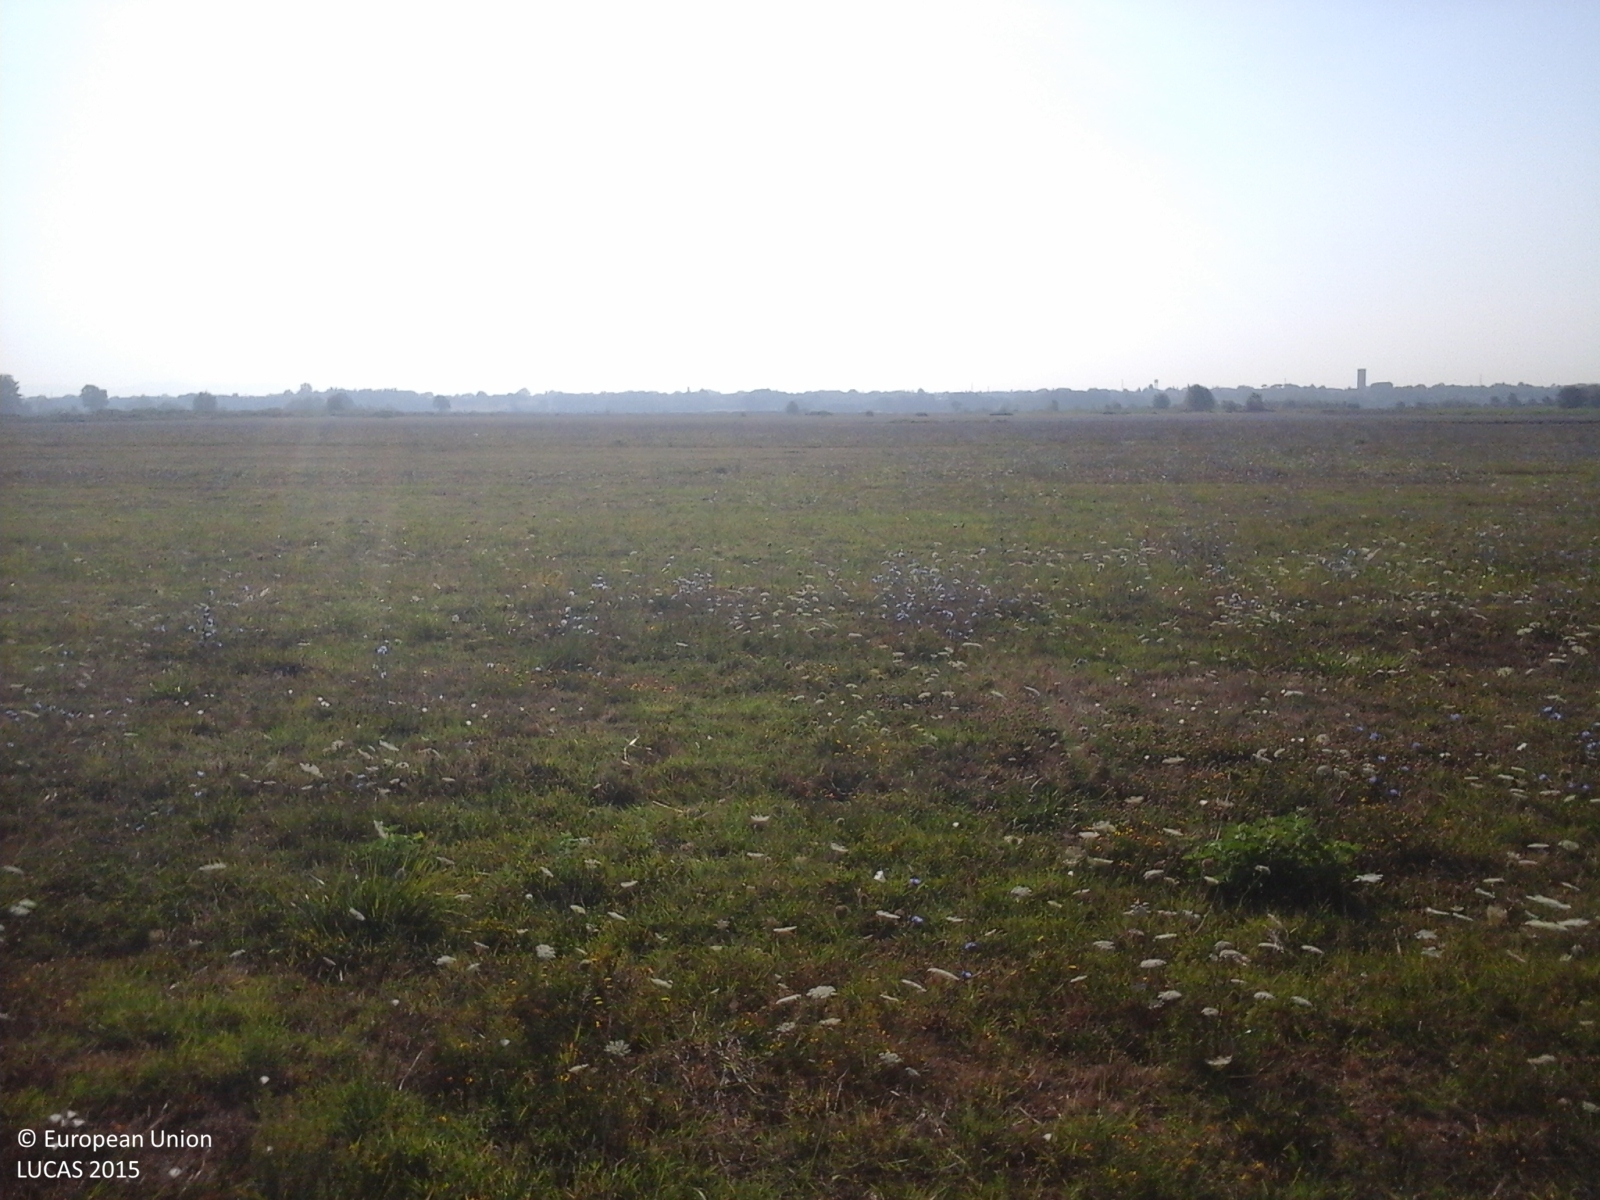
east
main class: Cropland
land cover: Temporary grasslands
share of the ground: > 75 %
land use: Agriculture (excluding fallow land and kitchen gardens)
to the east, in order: Temporary grasslands
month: August
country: IT
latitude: 43.7894
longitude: 10.6321
